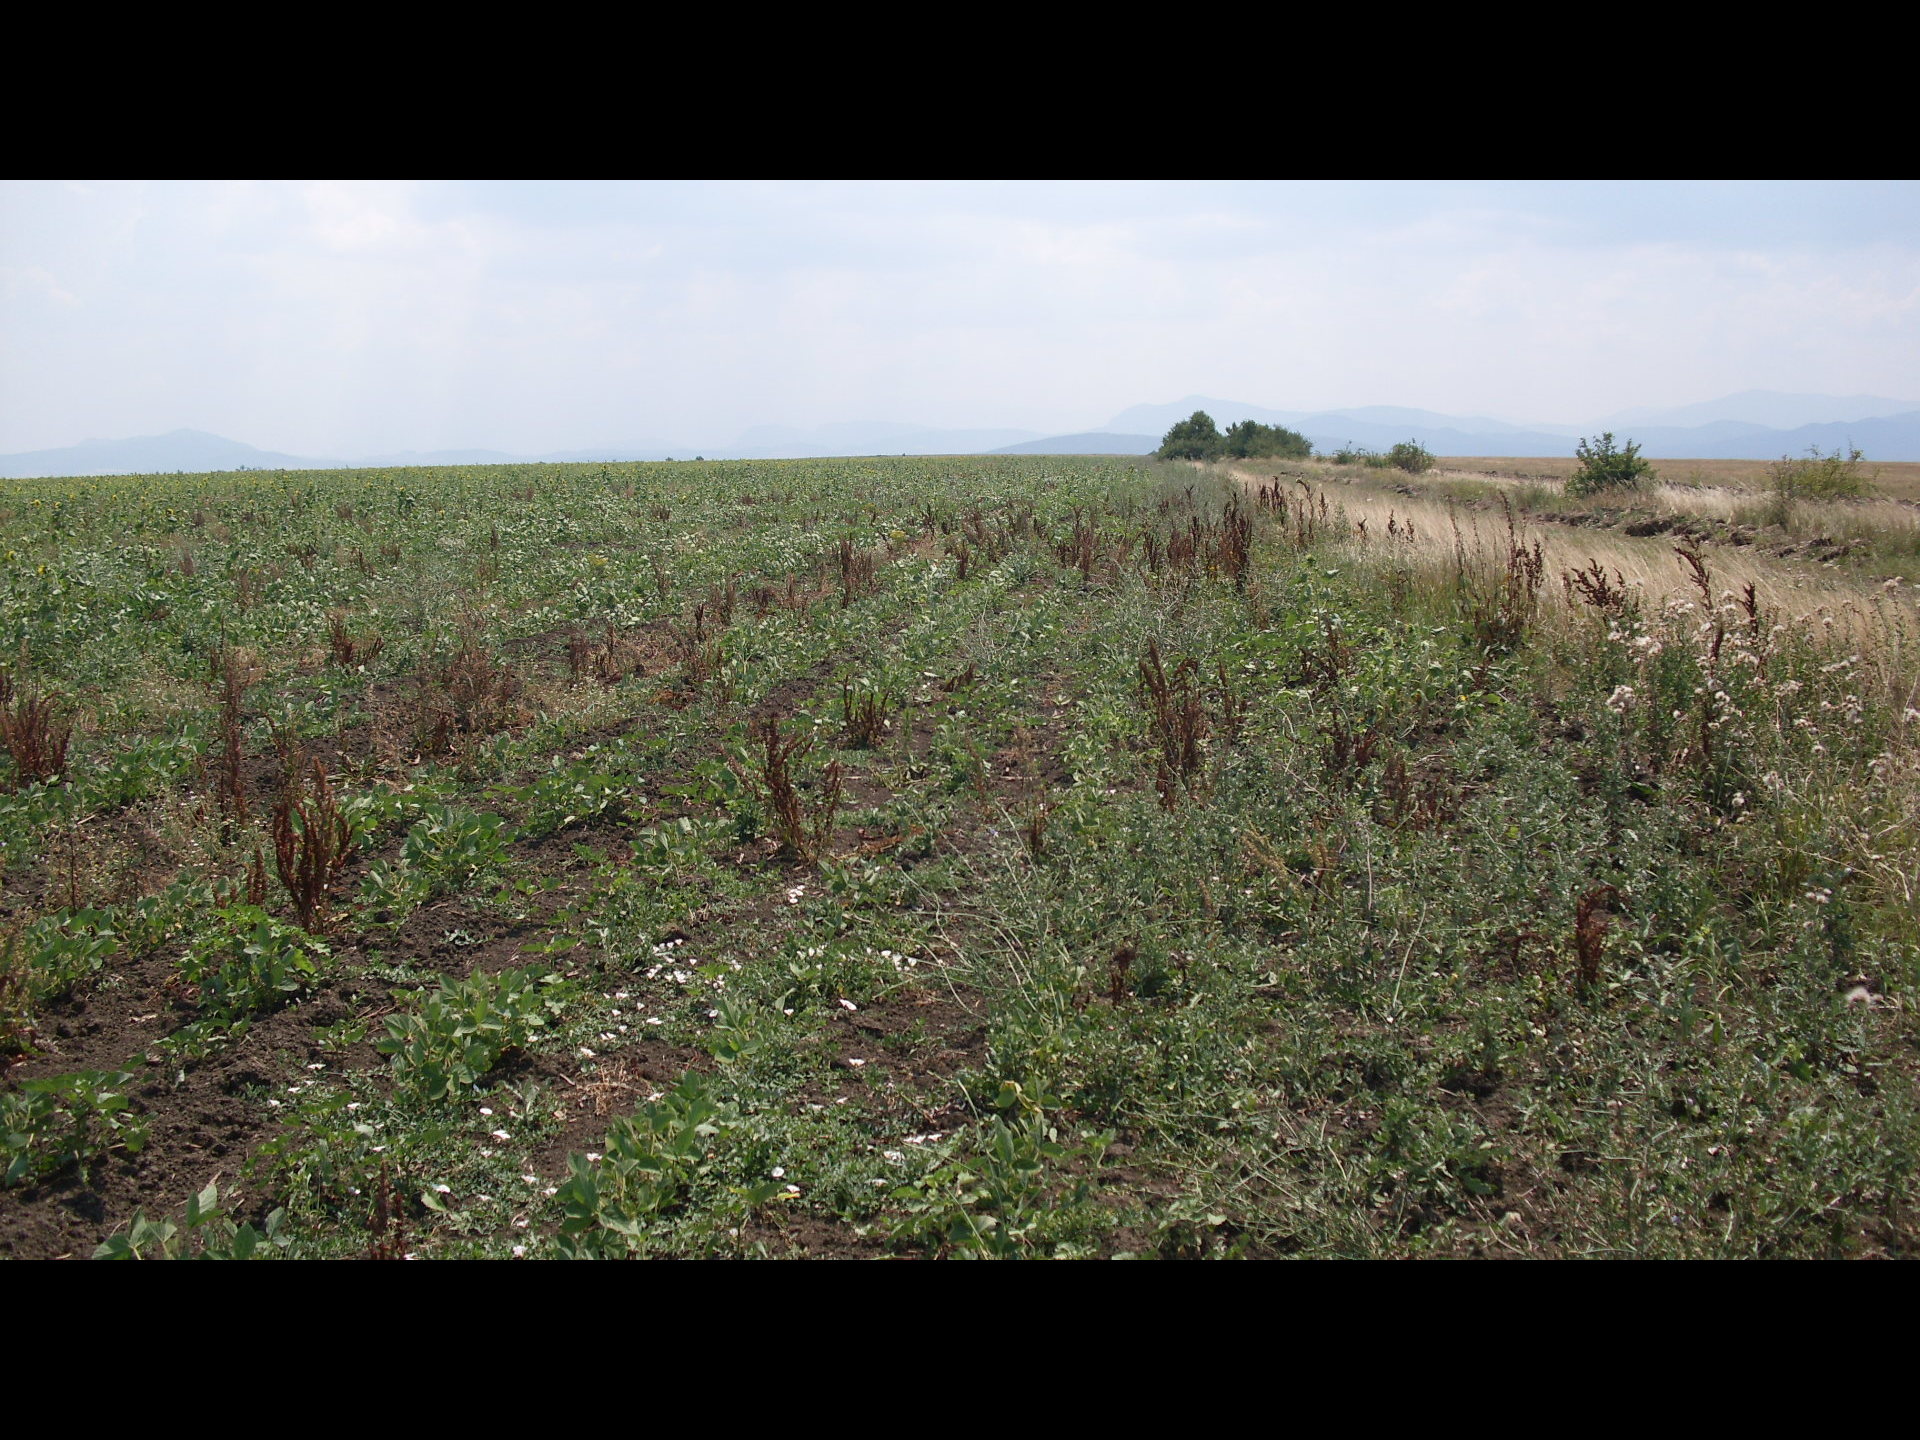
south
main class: Cropland
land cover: Soya
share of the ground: > 75 %
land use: Agriculture (excluding fallow land and kitchen gardens)
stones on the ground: < 10 %
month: July
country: BG
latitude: 43.8010
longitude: 22.5751
